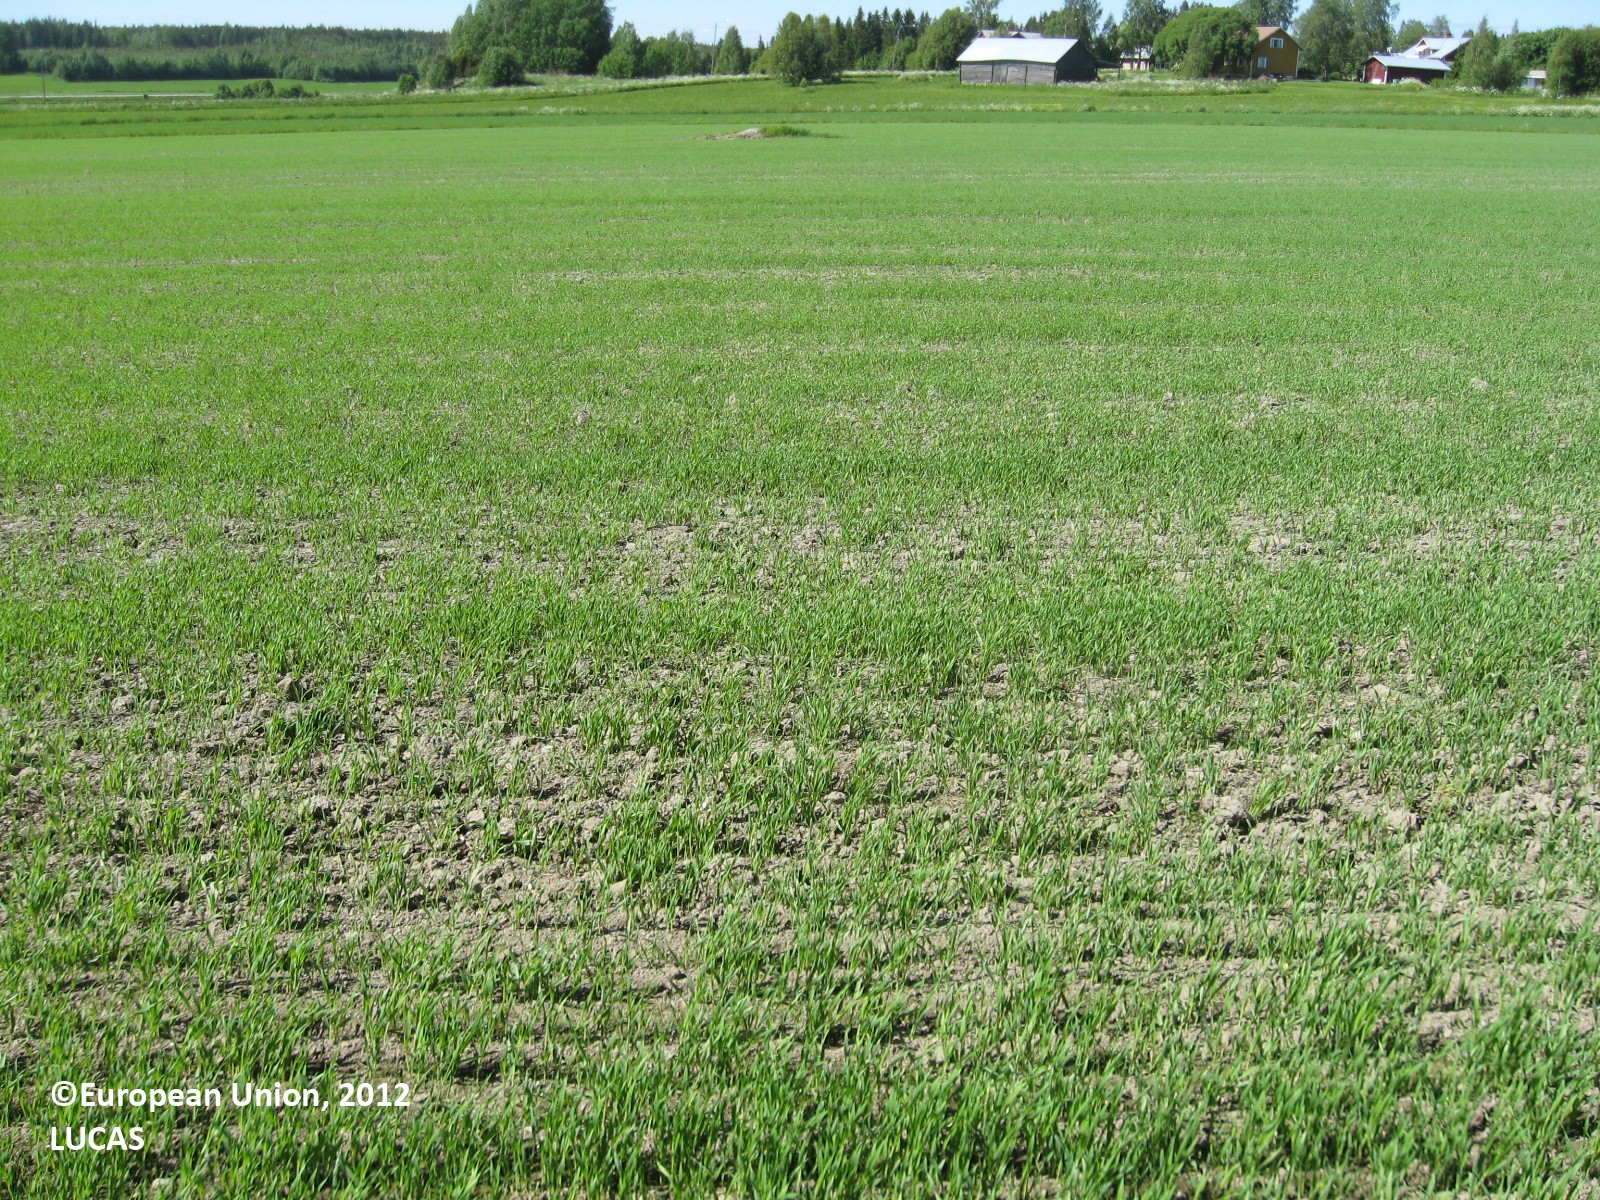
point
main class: Cropland
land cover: Rye
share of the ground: 50 - 75 %
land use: Agriculture (excluding fallow land and kitchen gardens)
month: June
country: FI
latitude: 62.9529
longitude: 21.7715
